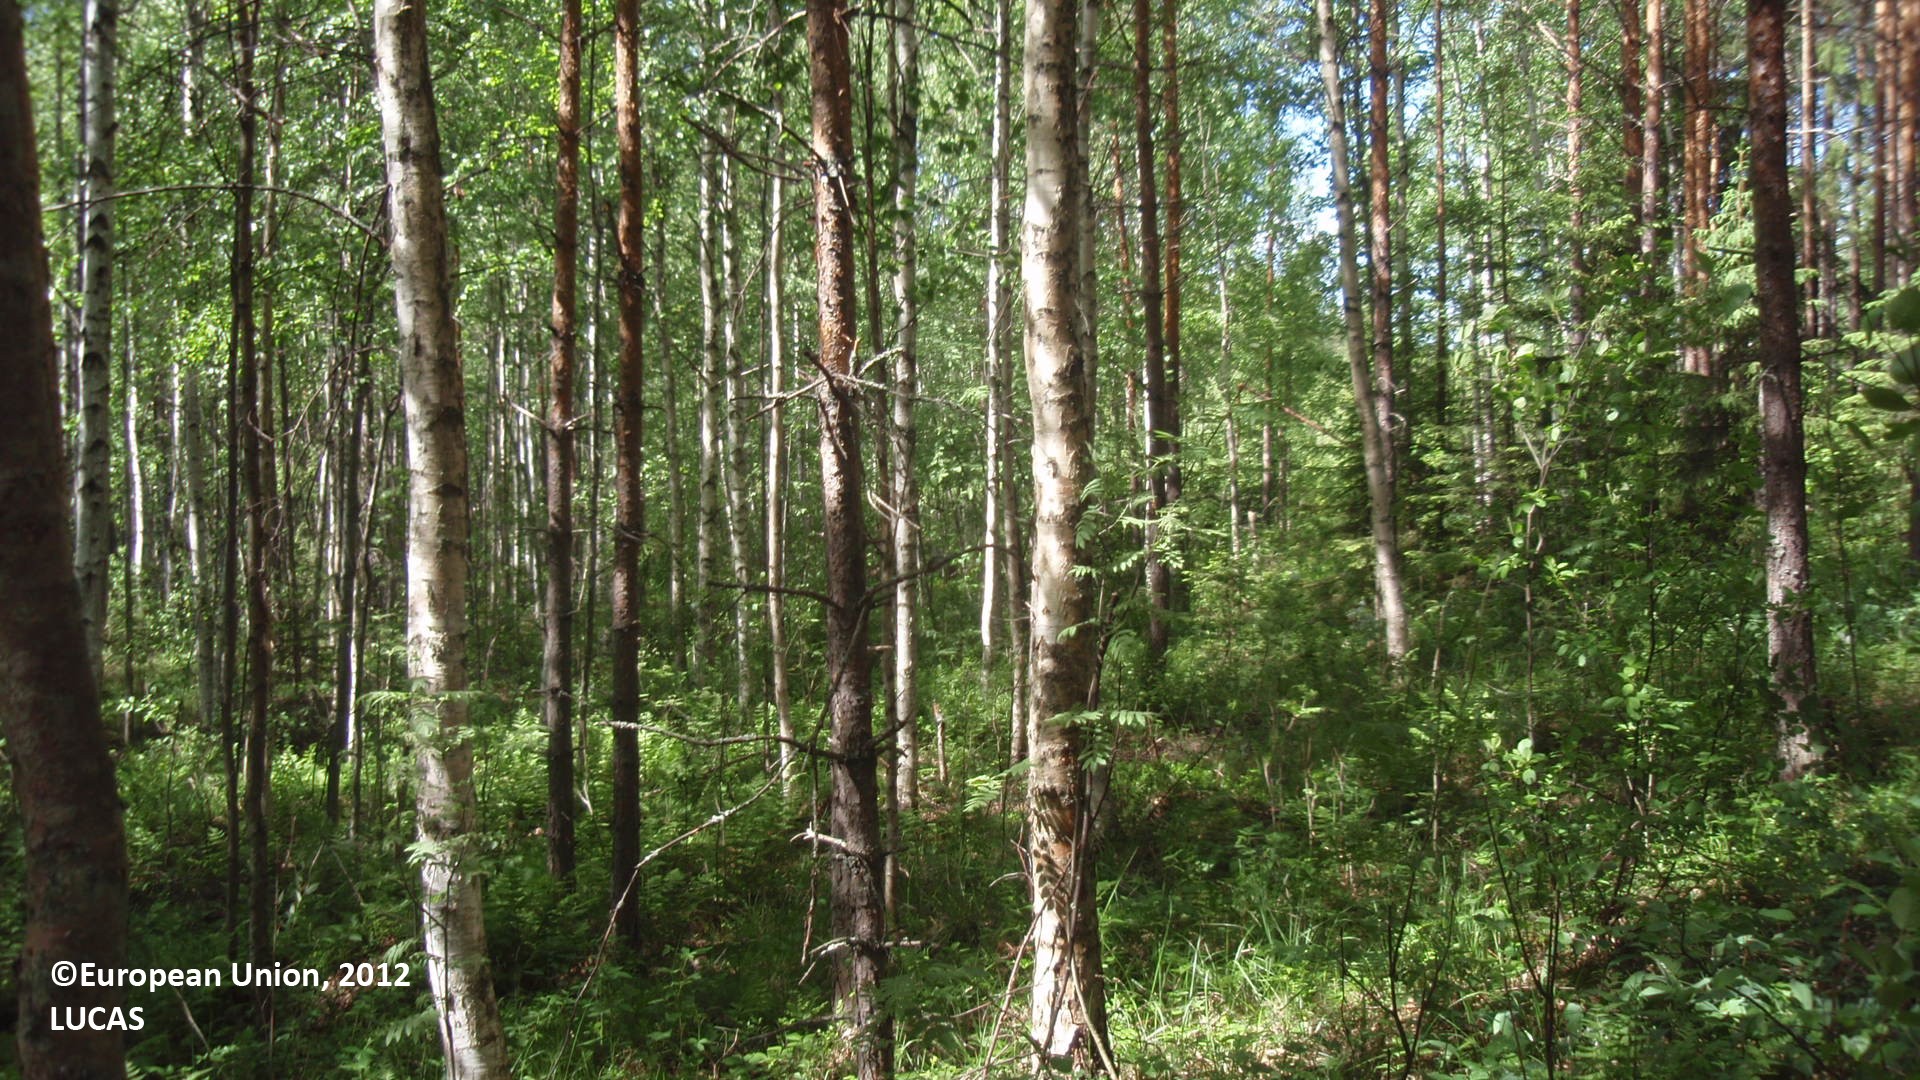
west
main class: Woodland
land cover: Pine dominated mixed woodland
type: boreal forest
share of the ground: > 75 %
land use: Forestry
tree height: > 5 m
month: June
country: FI
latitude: 61.6277
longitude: 28.4112
